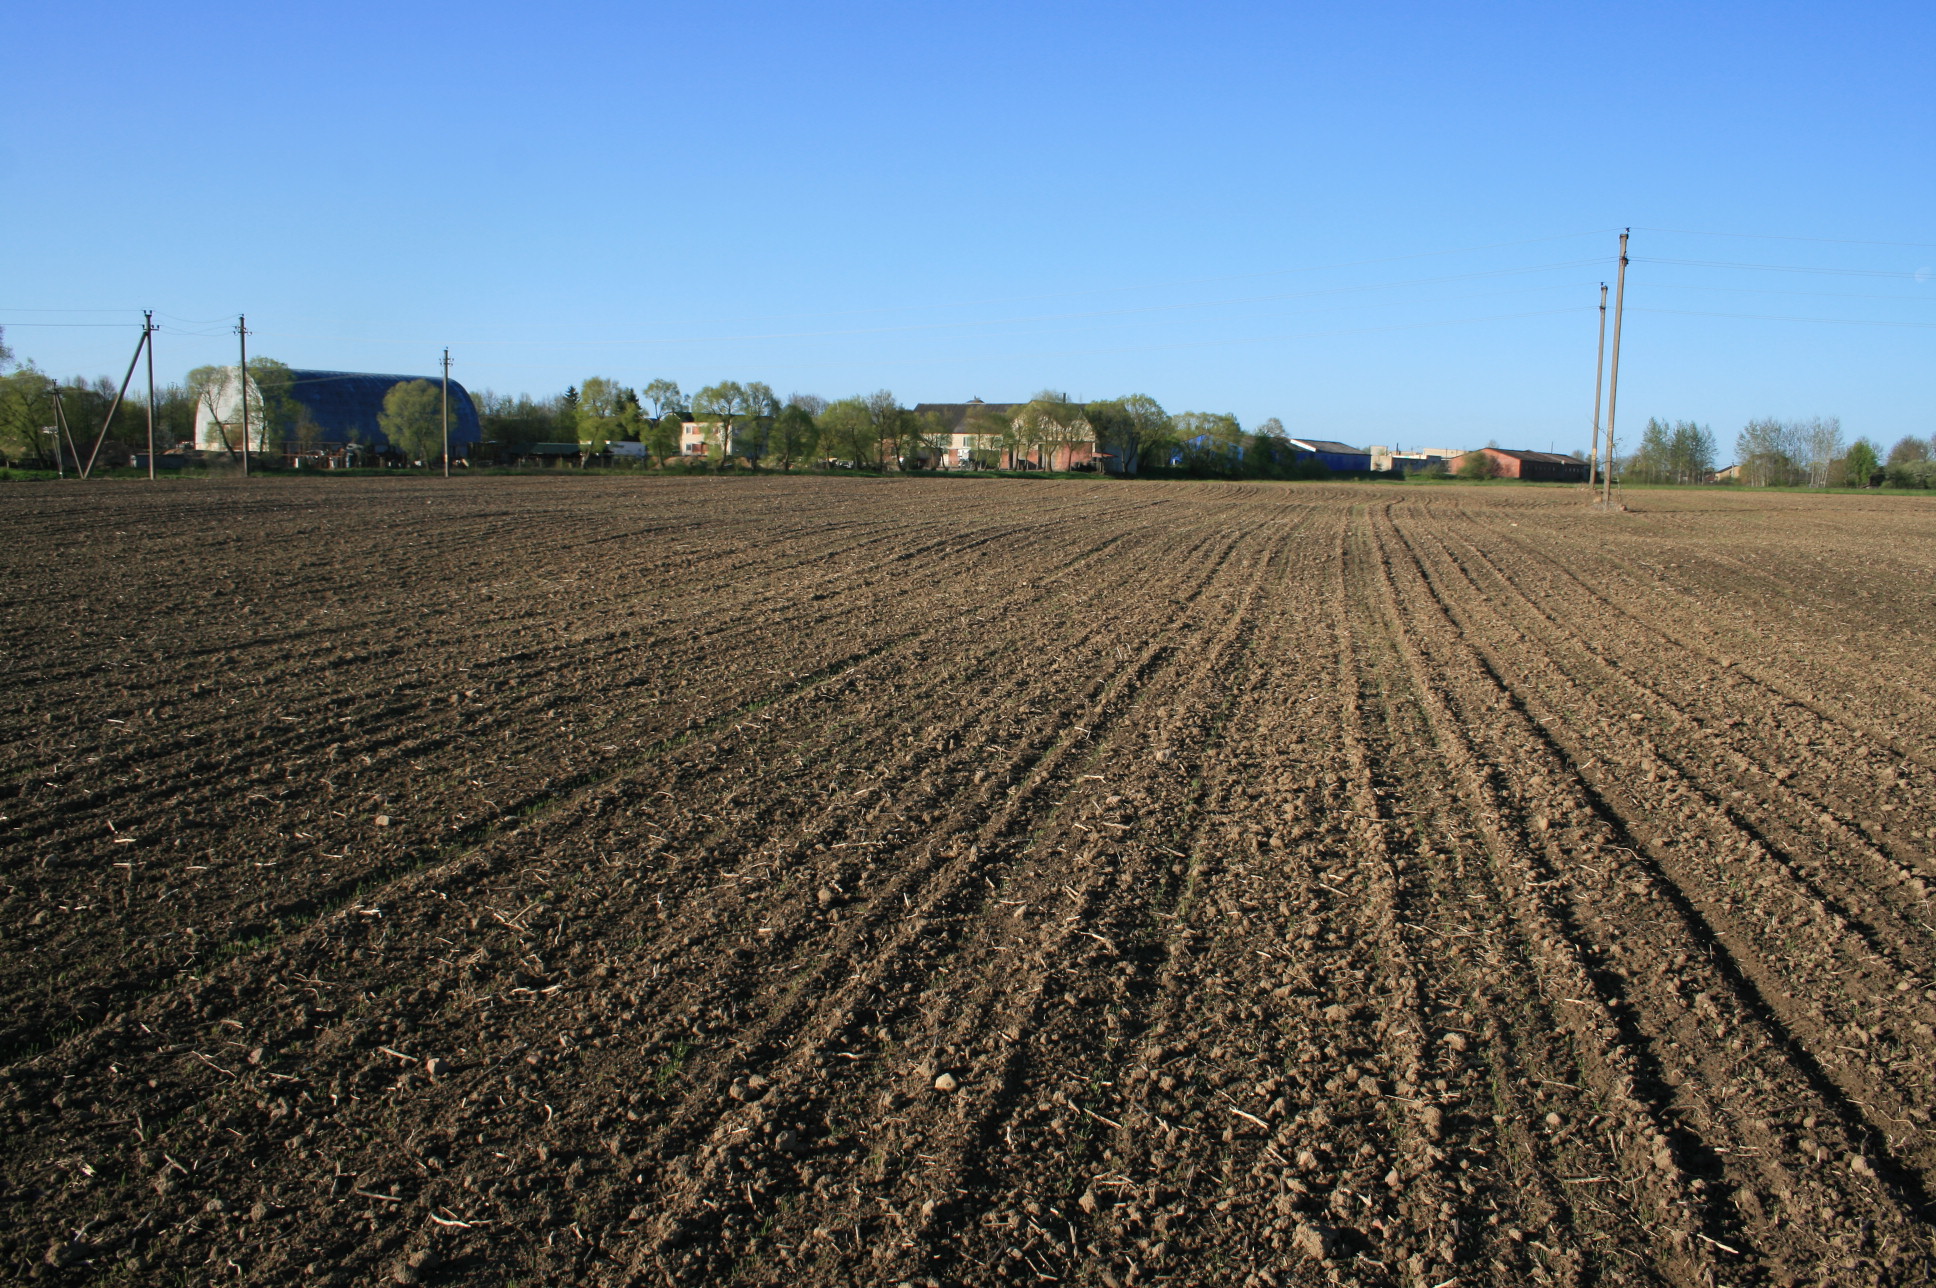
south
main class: Cropland
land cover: Common wheat
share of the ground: 10 - 25 %
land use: Agriculture (excluding fallow land and kitchen gardens)
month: May
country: LT
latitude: 56.2696
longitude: 21.4915
